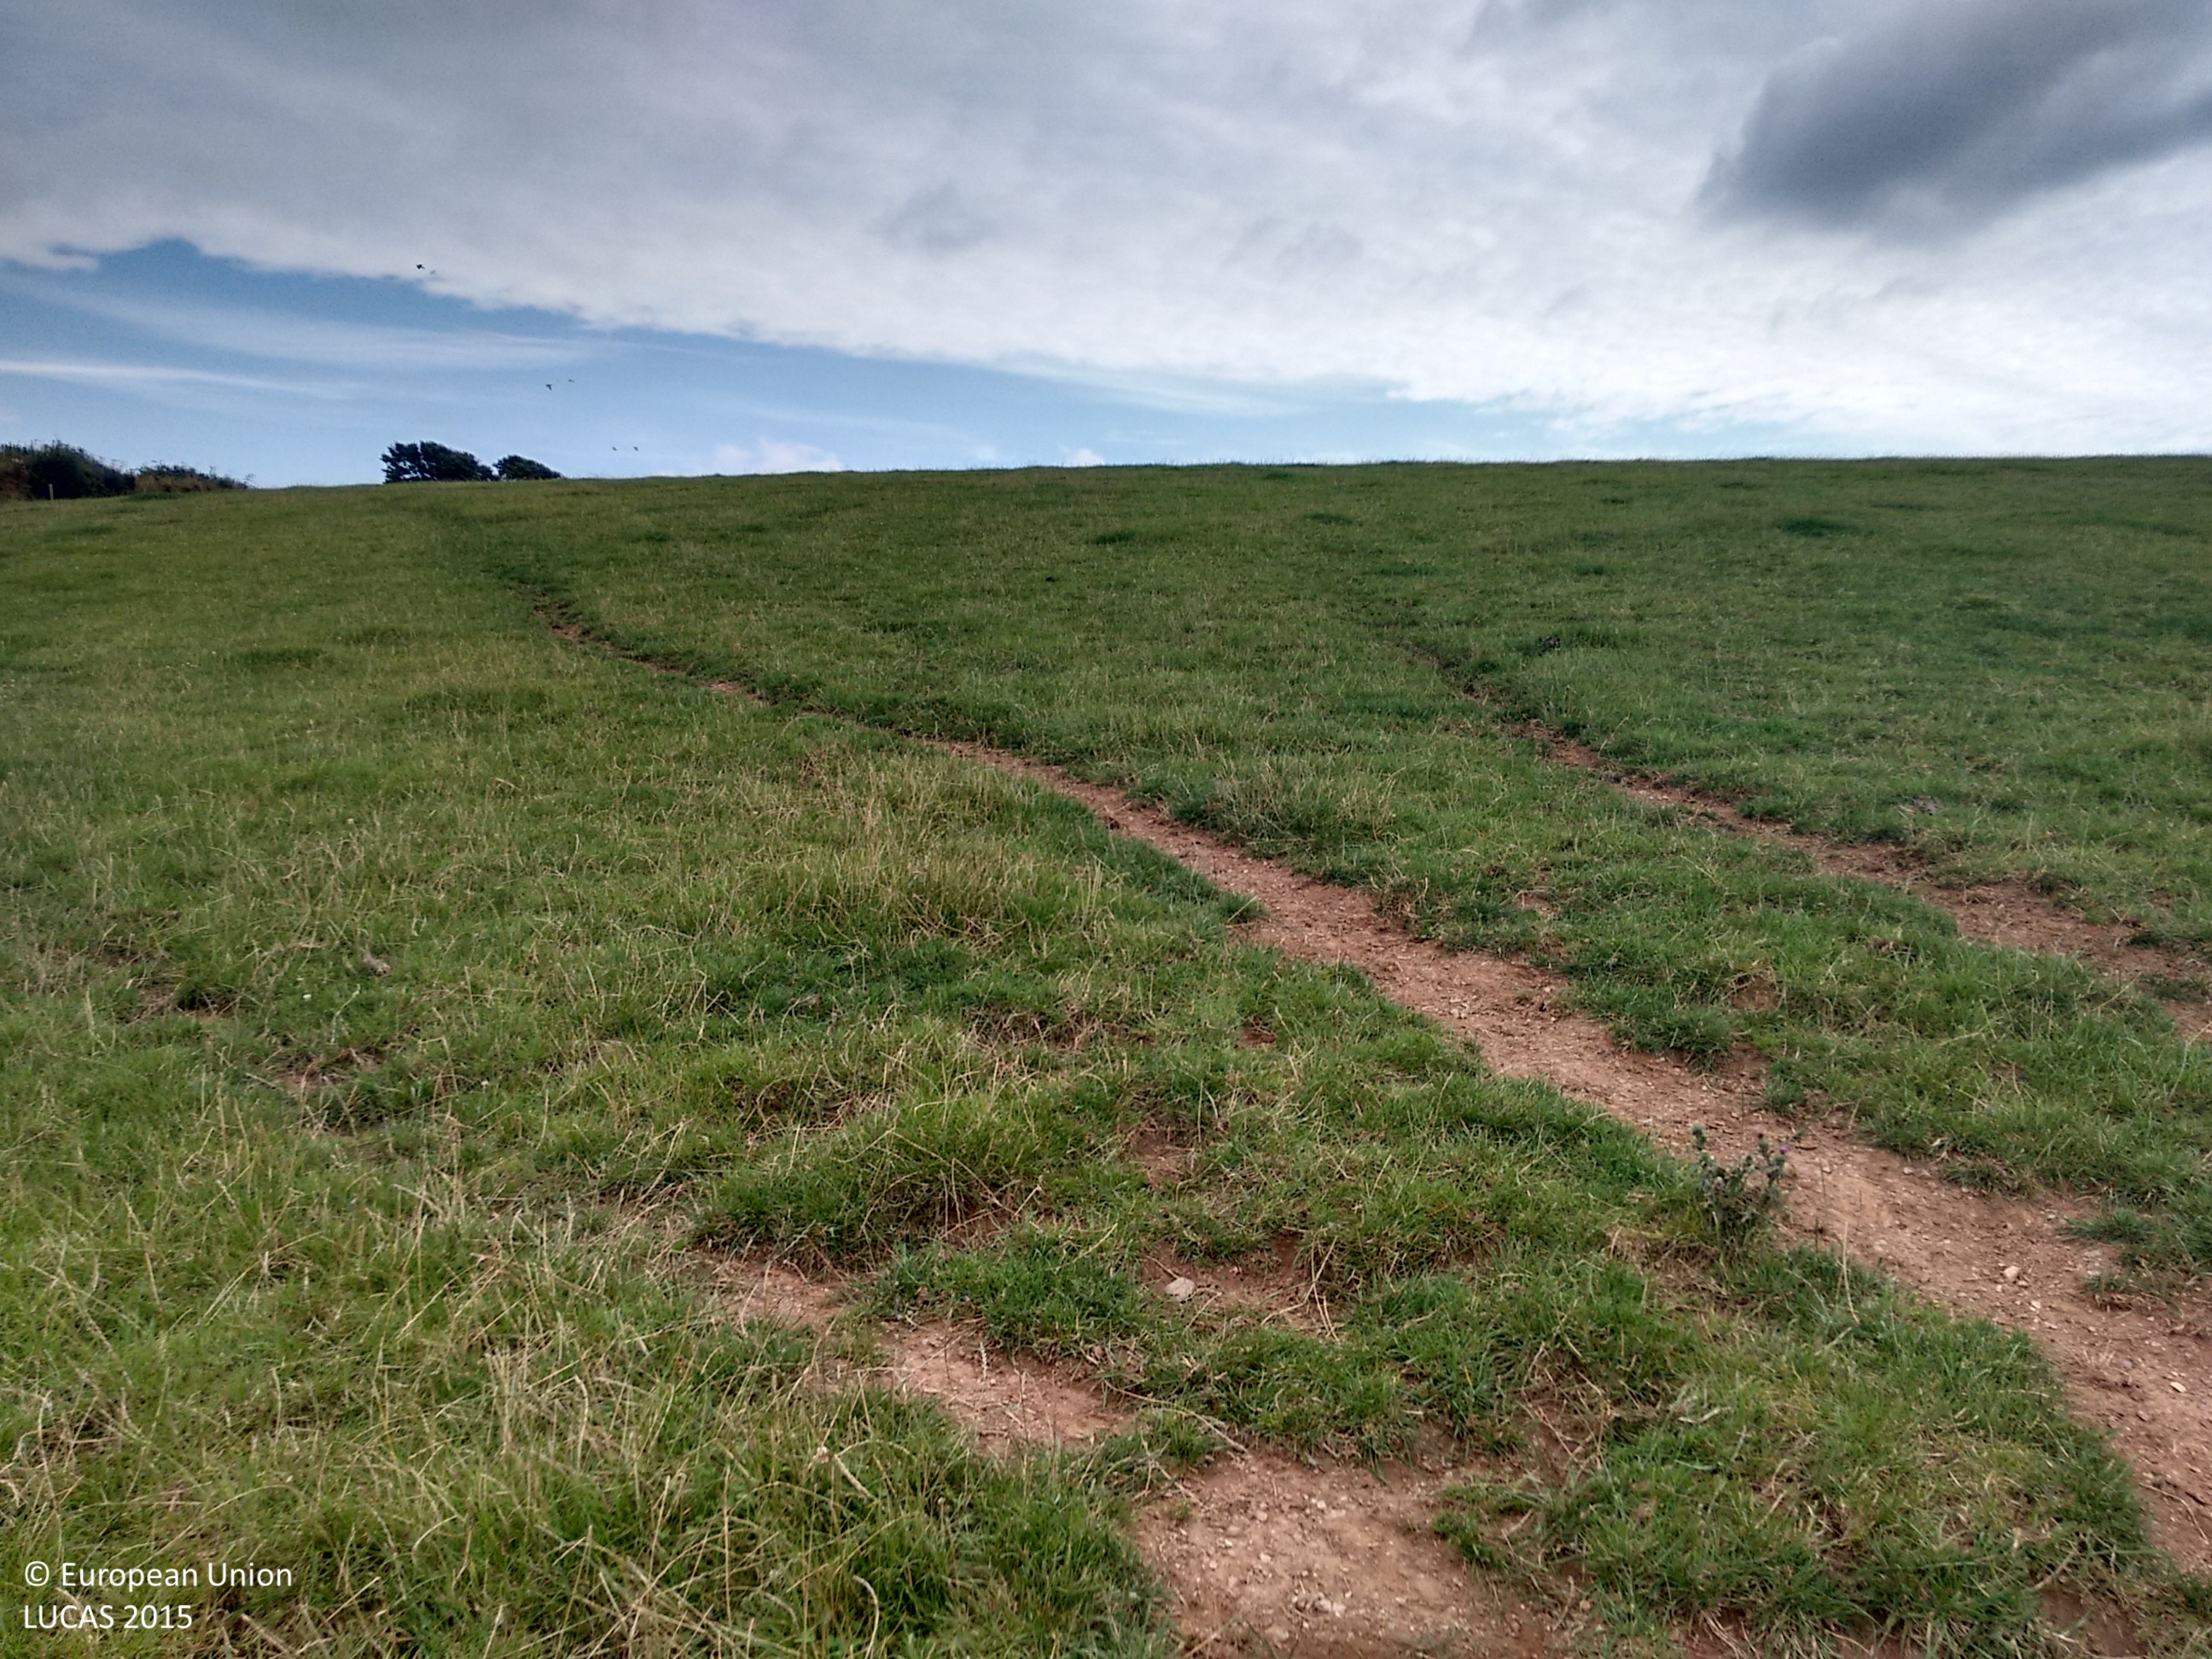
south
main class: Grassland
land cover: Grassland without tree/shrub cover
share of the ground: > 75 %
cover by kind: herbaceous plants 100 %
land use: Agriculture (excluding fallow land and kitchen gardens)
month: August
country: GB
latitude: 50.4131
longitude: -4.2702
